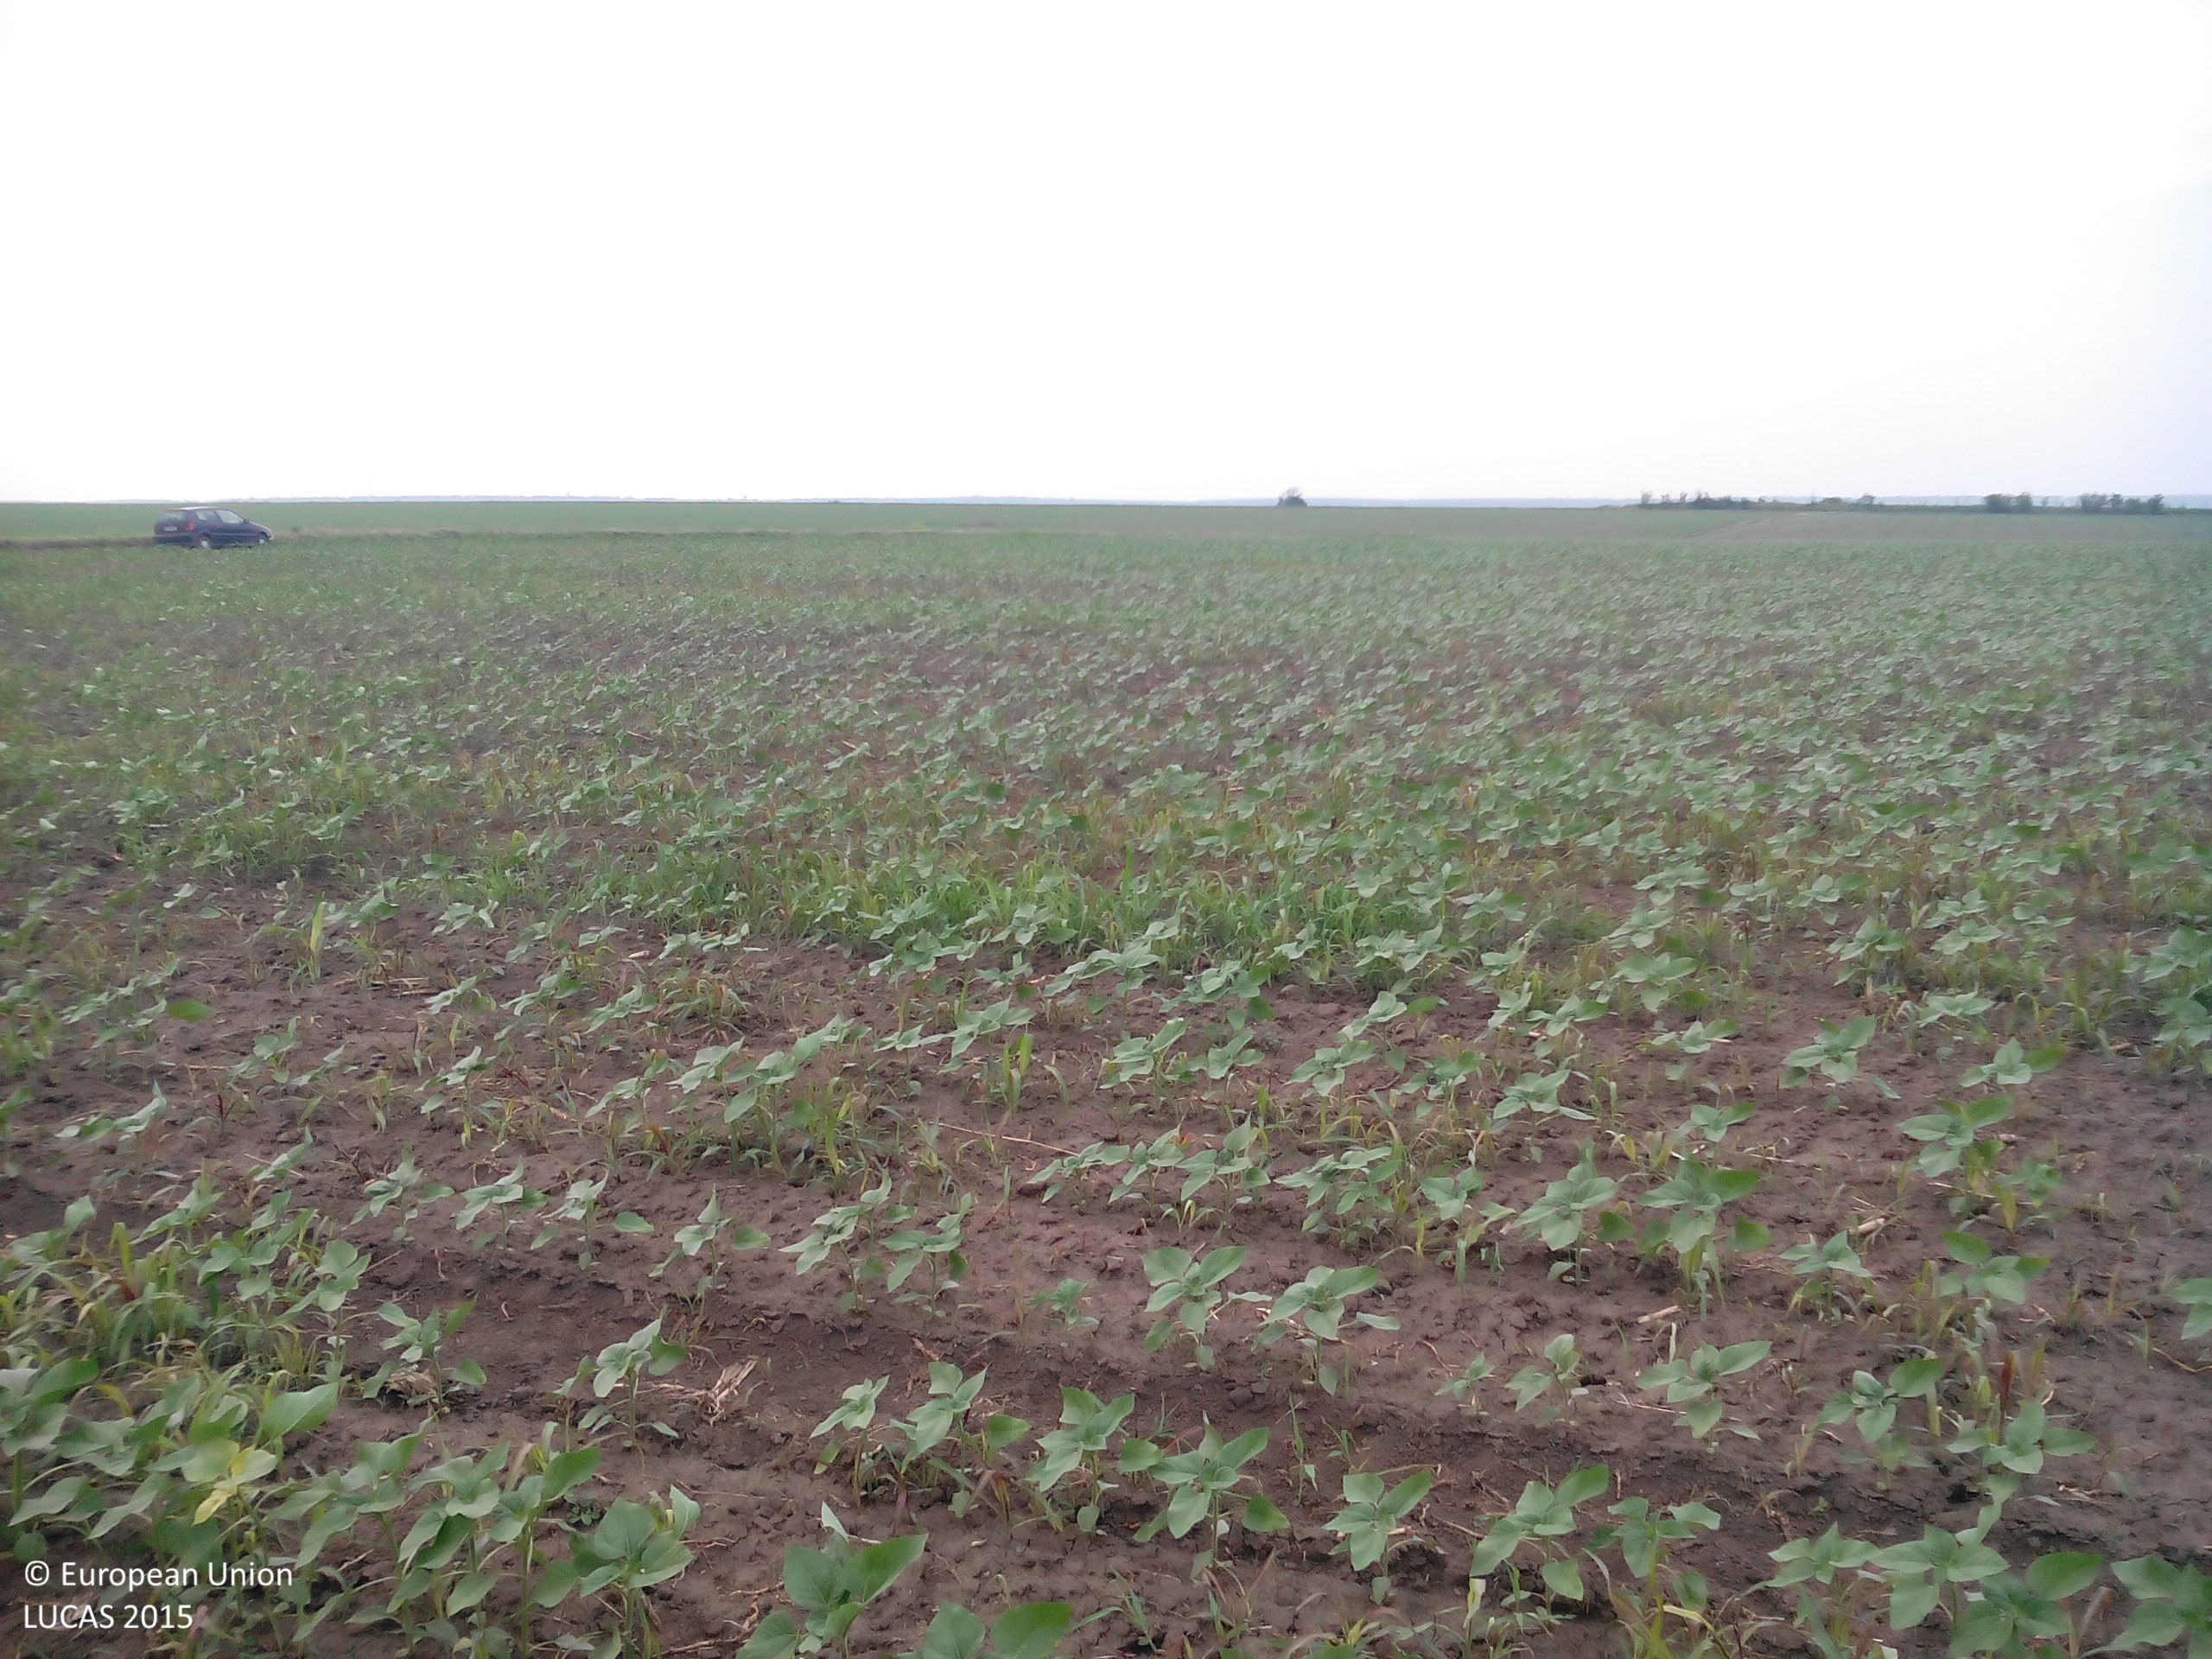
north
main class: Cropland
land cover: Sunflower
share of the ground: 25 - 50 %
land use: Agriculture (excluding fallow land and kitchen gardens)
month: May
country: BG
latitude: 43.6070
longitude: 24.1934
